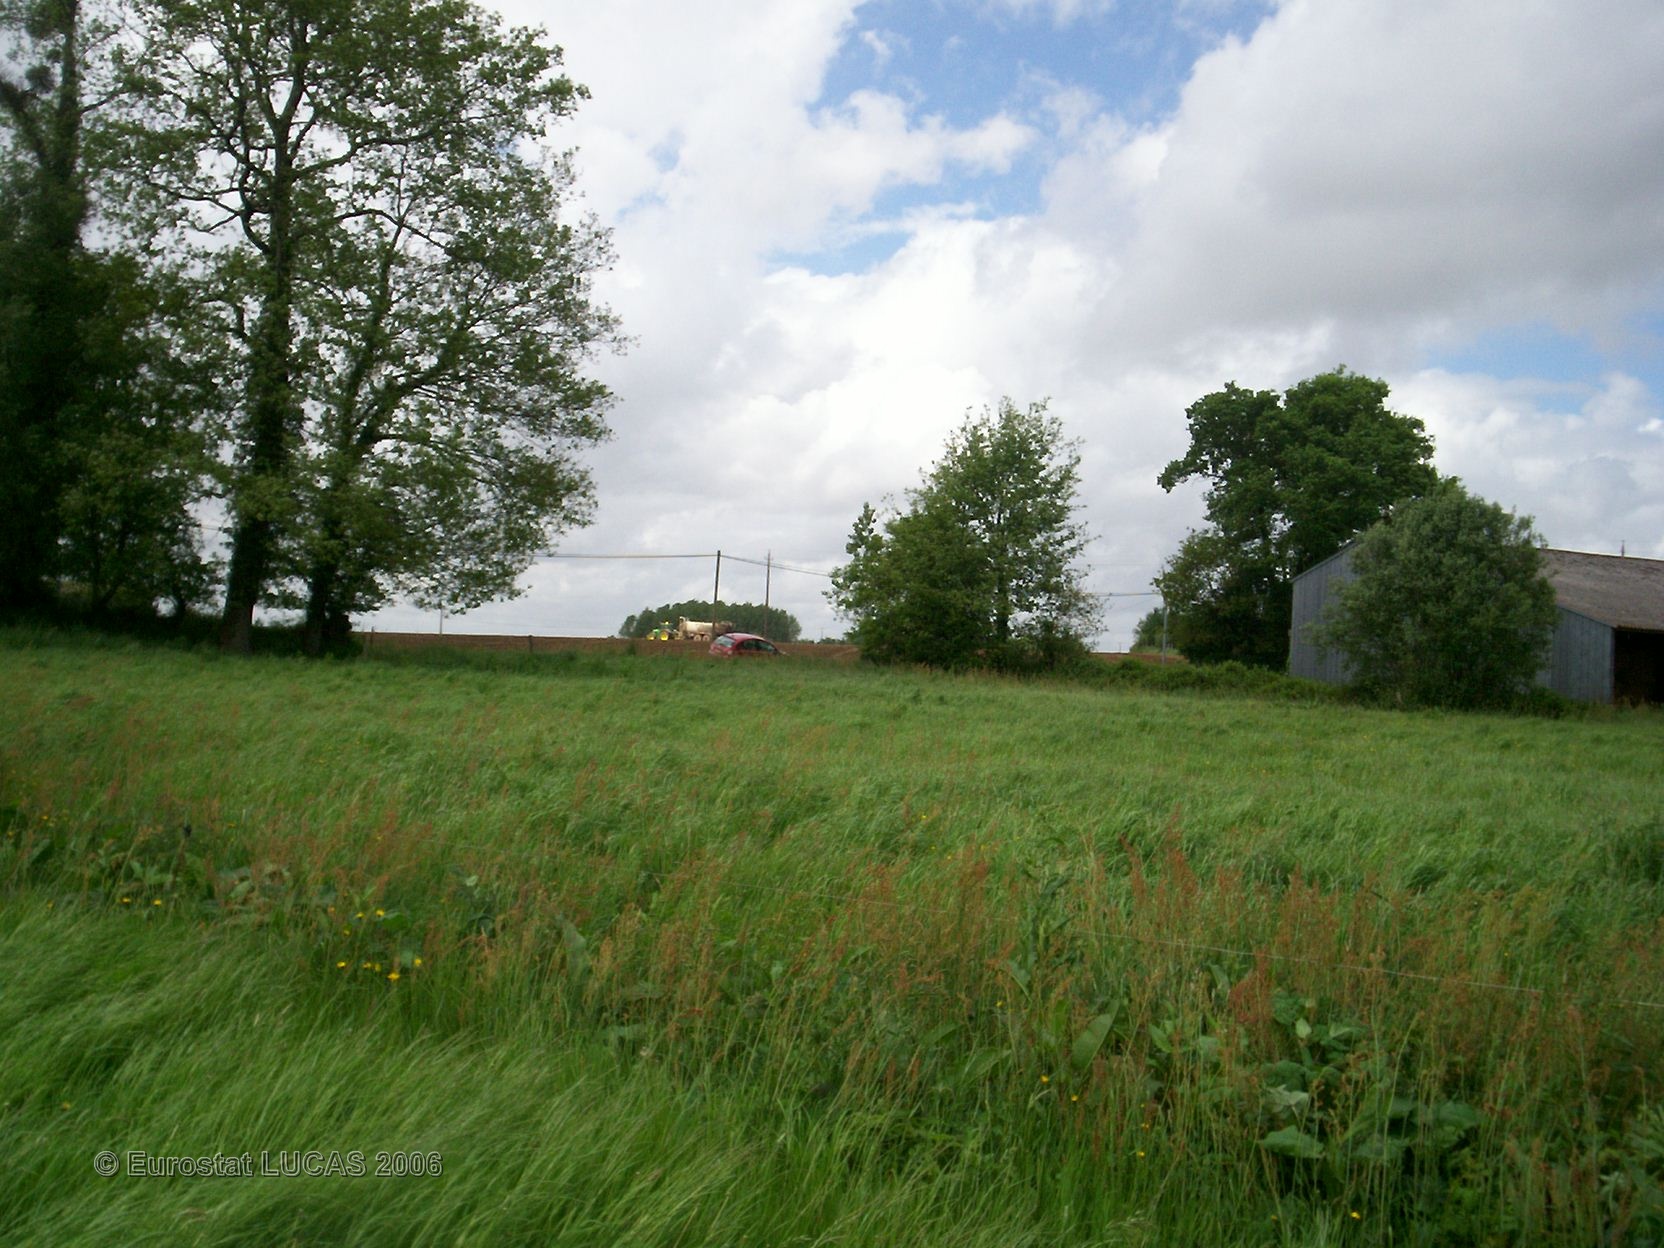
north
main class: Grassland
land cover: Grassland without tree/shrub cover
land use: Agriculture (excluding fallow land and kitchen gardens)
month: May
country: FR
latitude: 47.9092
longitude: -2.8145
